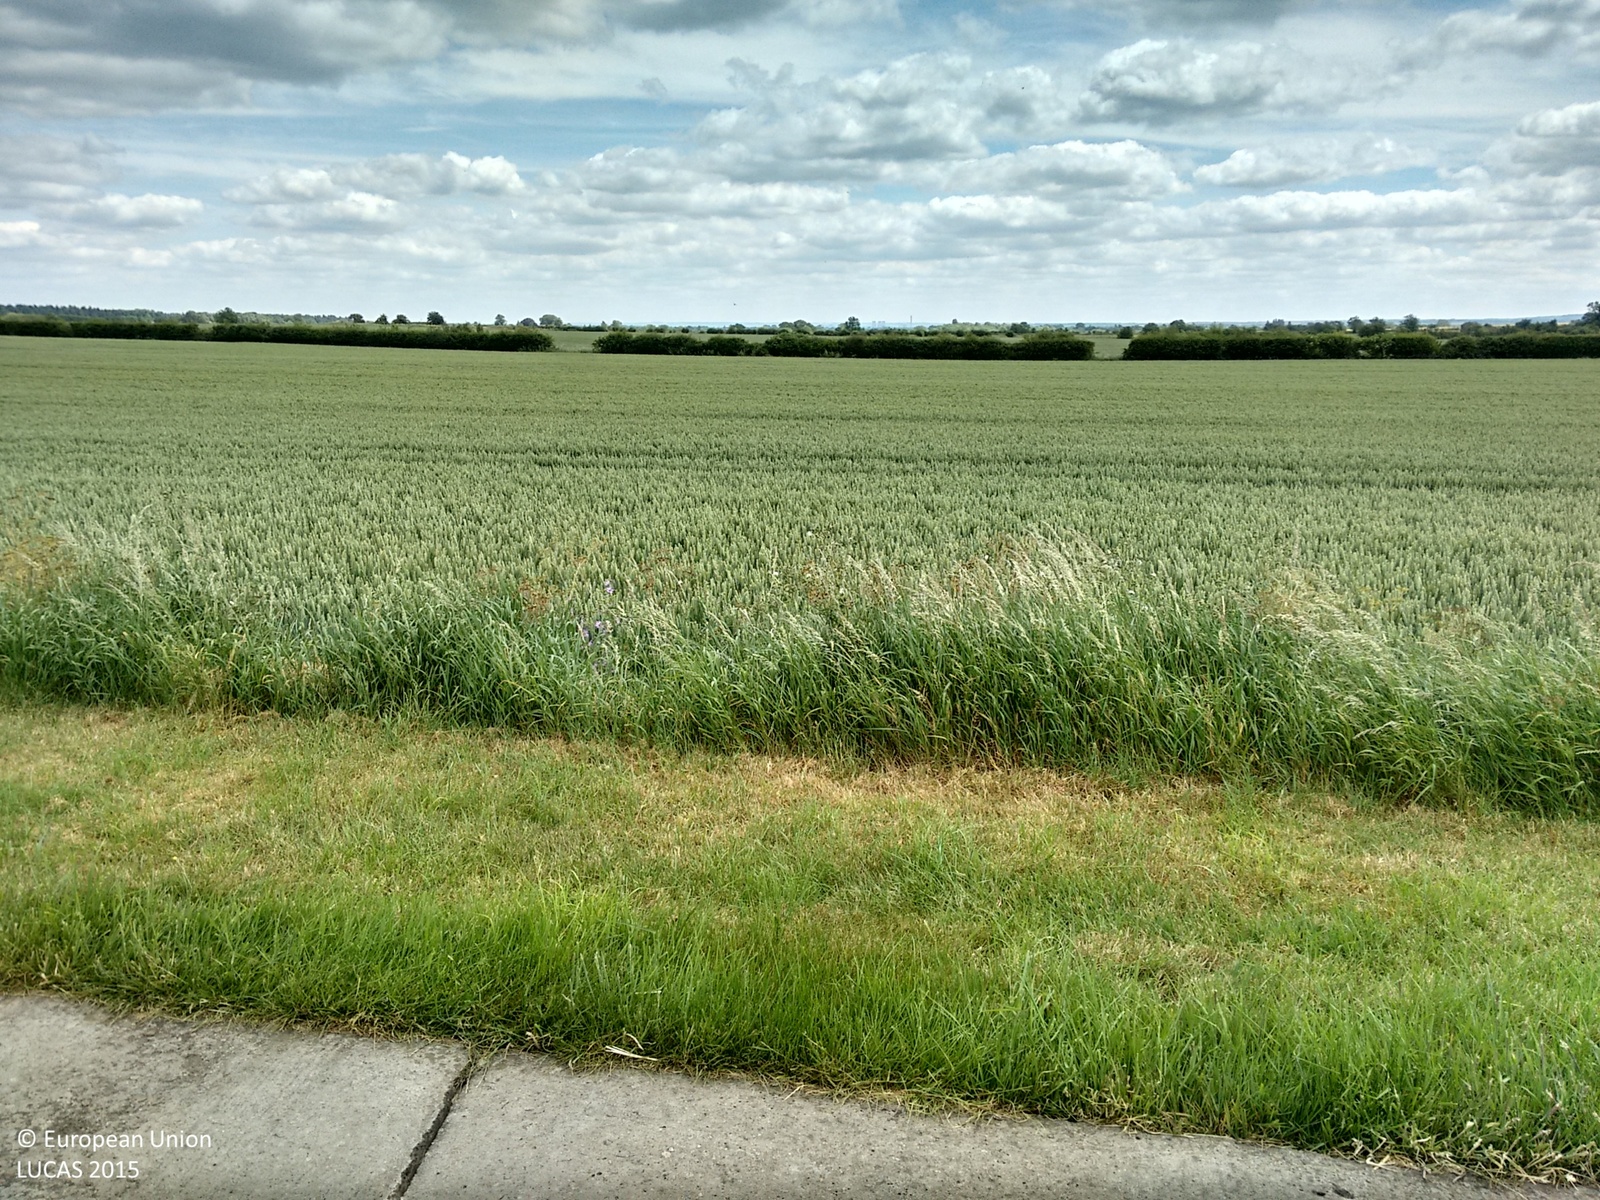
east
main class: Cropland
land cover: Common wheat
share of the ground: > 75 %
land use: Agriculture (excluding fallow land and kitchen gardens)
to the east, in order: Common wheat; Grass margins; Paved roads, cycling and walking lanes; Grass margins; Common wheat
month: June
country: GB
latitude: 51.6488
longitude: -1.5417
